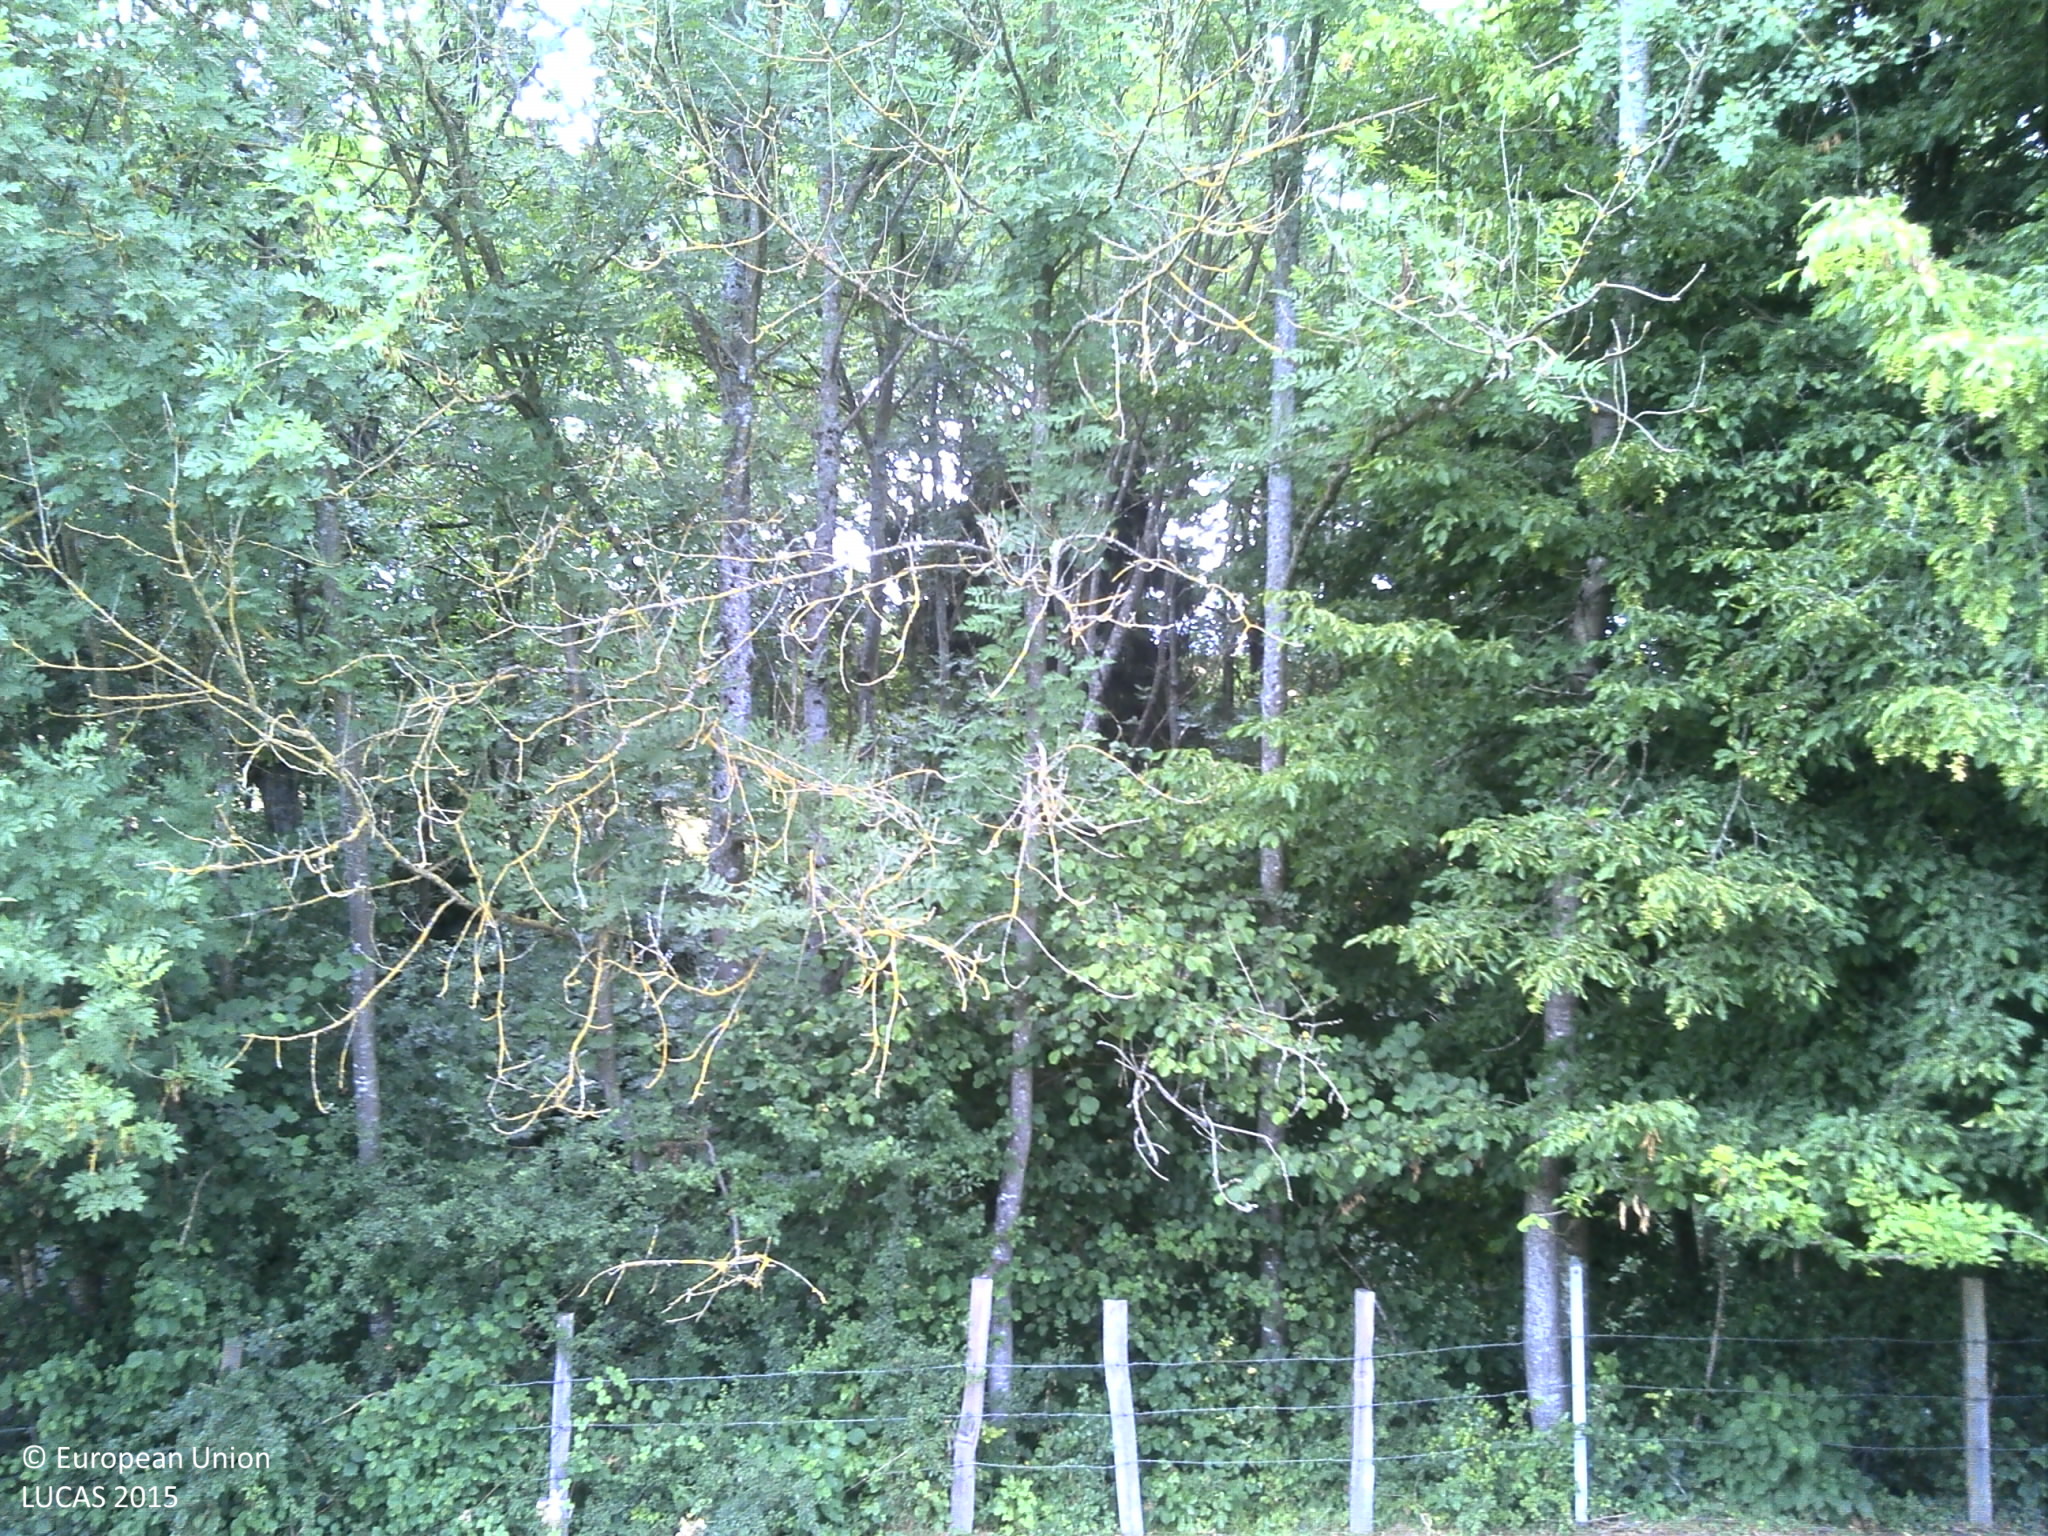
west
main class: Grassland
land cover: Grassland with sparse tree/shrub cover
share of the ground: > 75 %
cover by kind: herbaceous plants 95 %, broadleaved forest trees 5 %
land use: Agriculture (excluding fallow land and kitchen gardens)
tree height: > 5 m
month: July
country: FR
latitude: 48.7837
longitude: 7.2651
